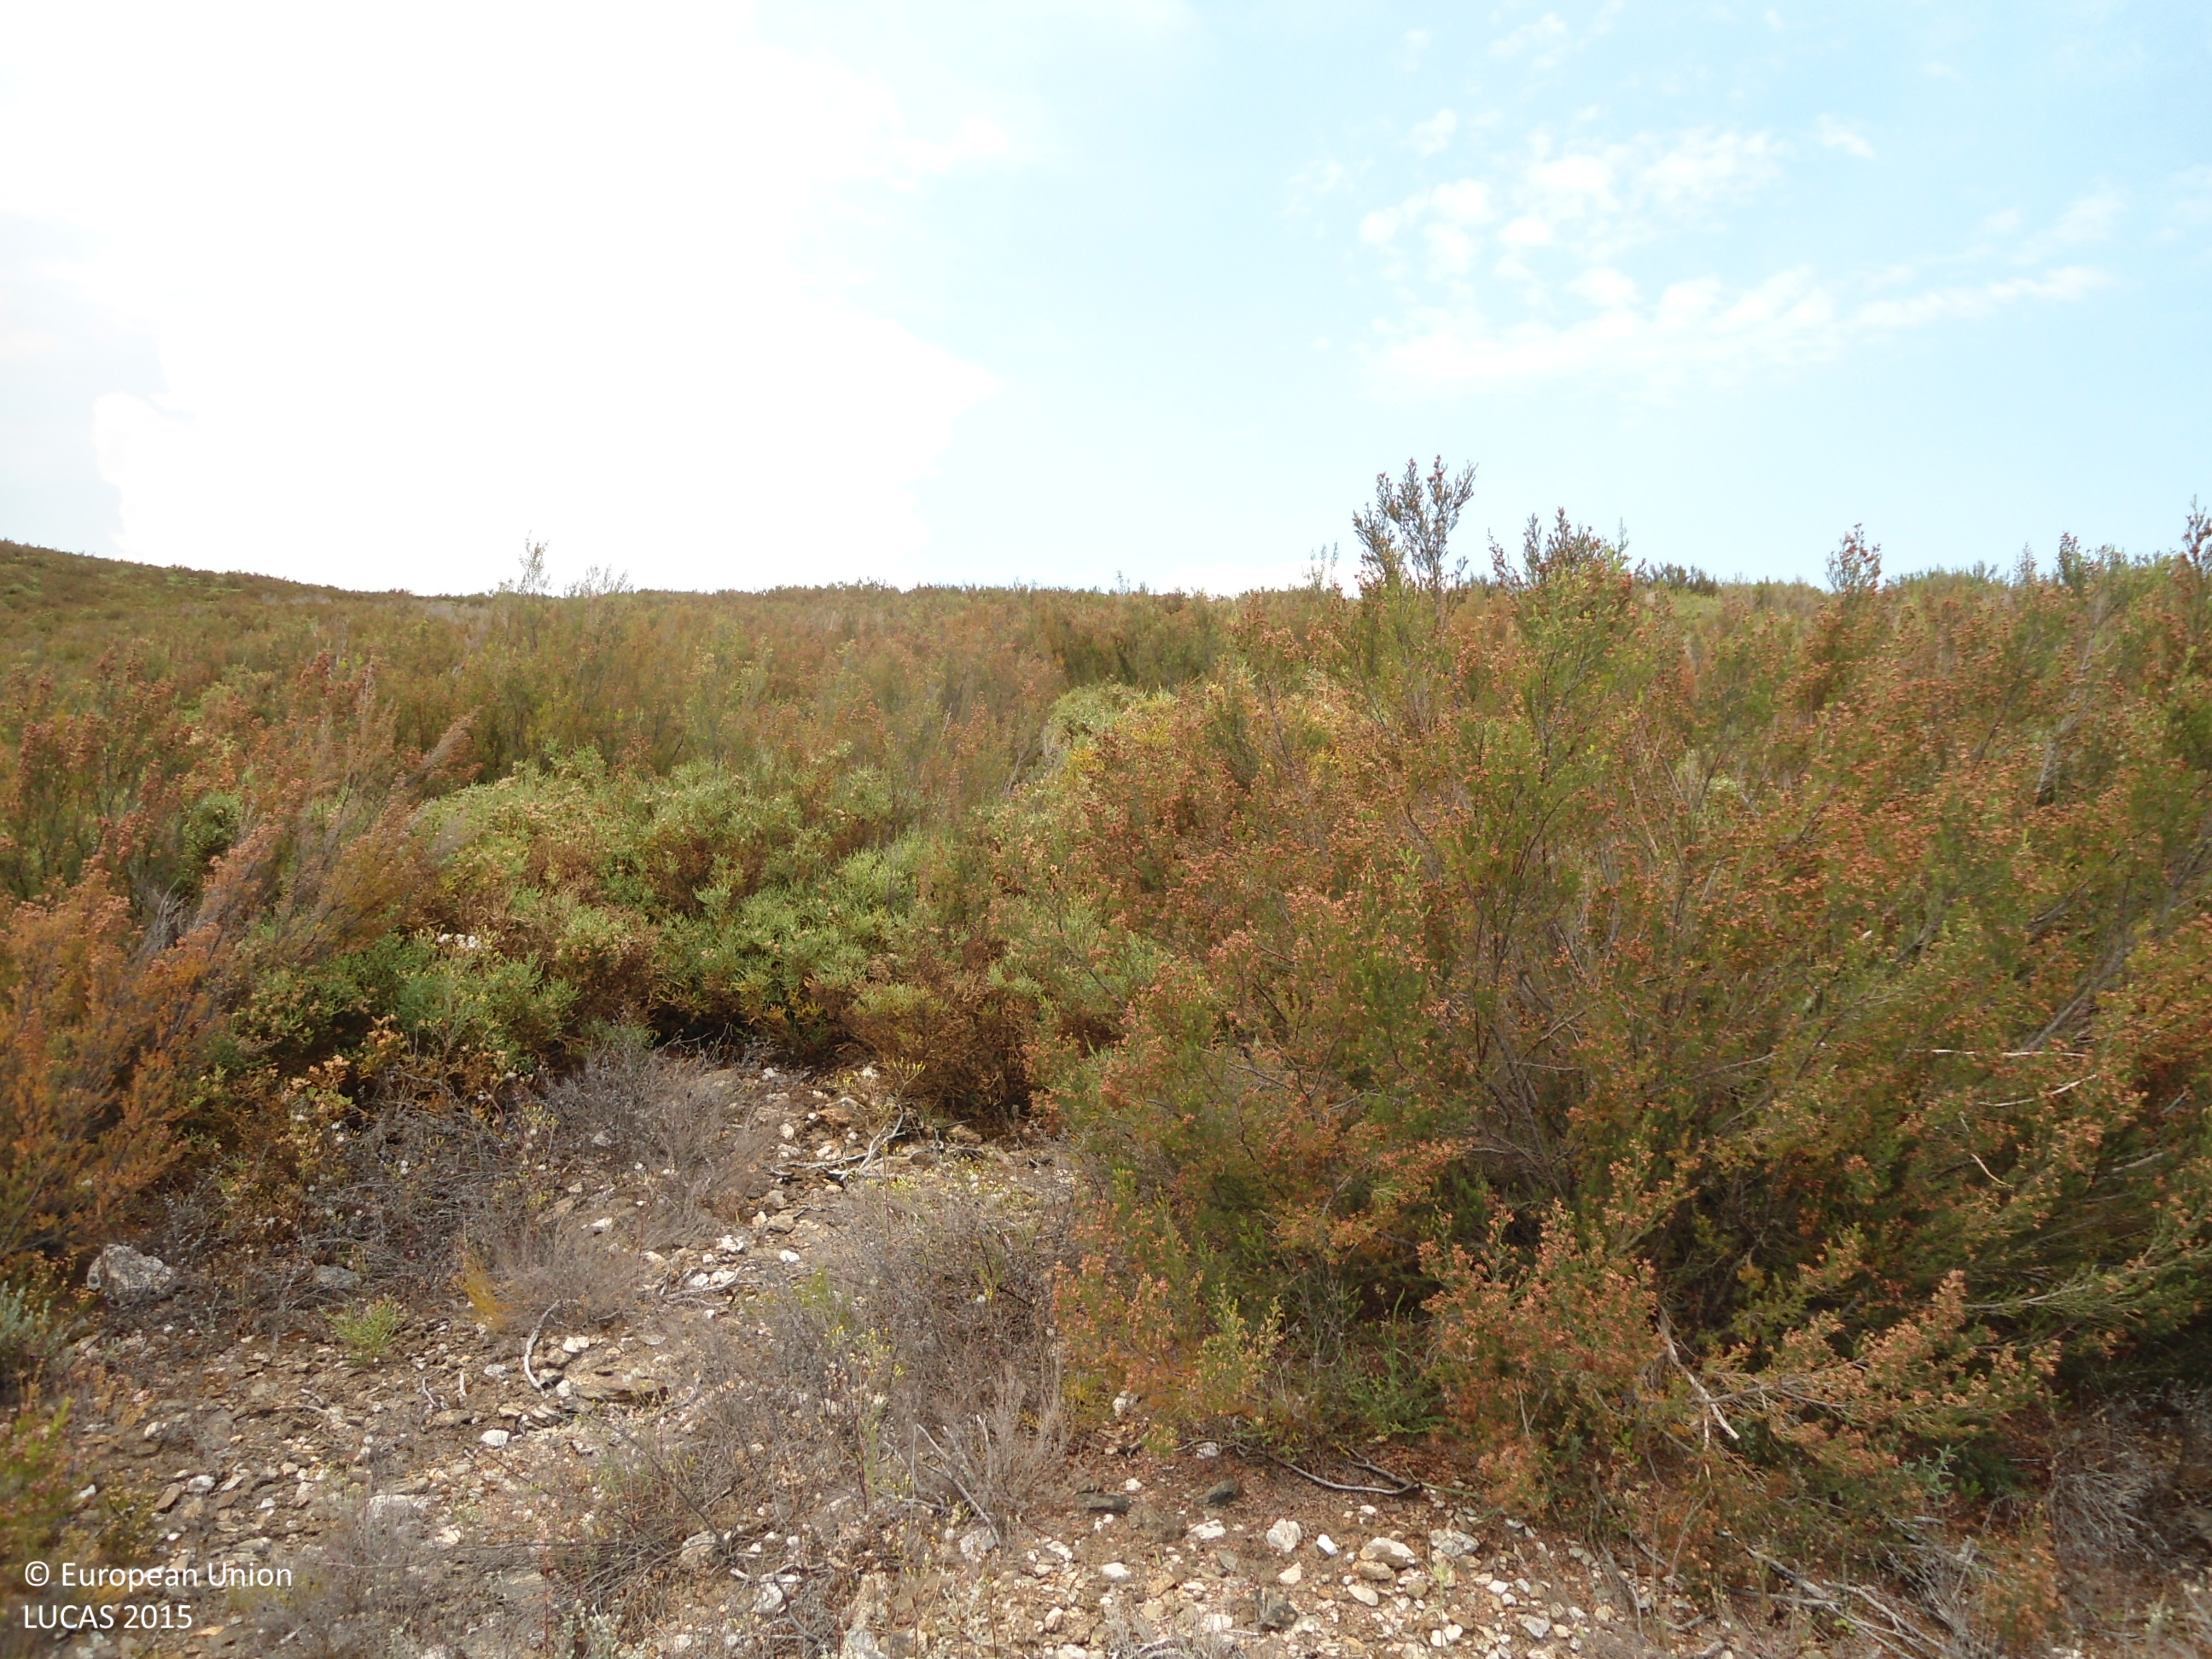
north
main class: Shrubland
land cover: Shrubland without tree cover
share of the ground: > 75 %
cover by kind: shrubs 100 %
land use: Semi-natural and natural areas not in use
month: June
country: ES
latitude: 41.9685
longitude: -6.7309
